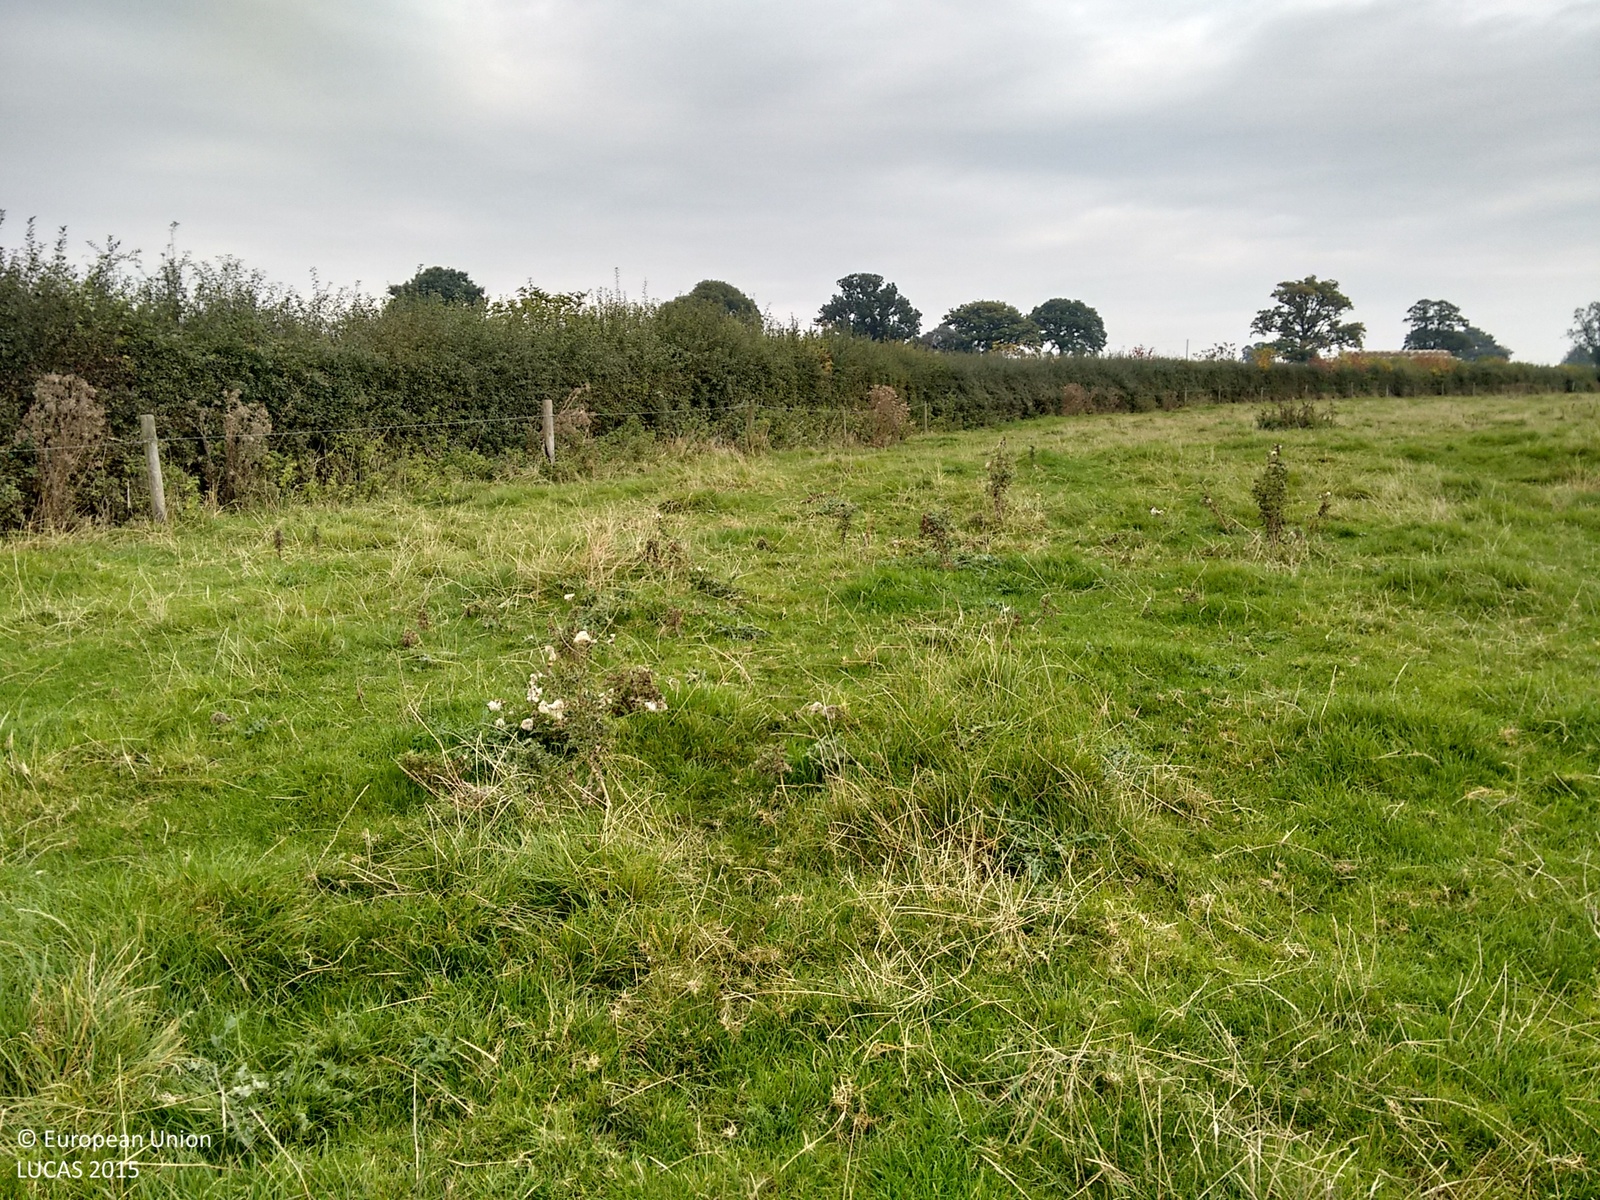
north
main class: Grassland
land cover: Grassland without tree/shrub cover
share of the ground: > 75 %
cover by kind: herbaceous plants 100 %
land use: Agriculture (excluding fallow land and kitchen gardens)
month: October
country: GB
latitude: 52.6684
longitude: -2.5927
